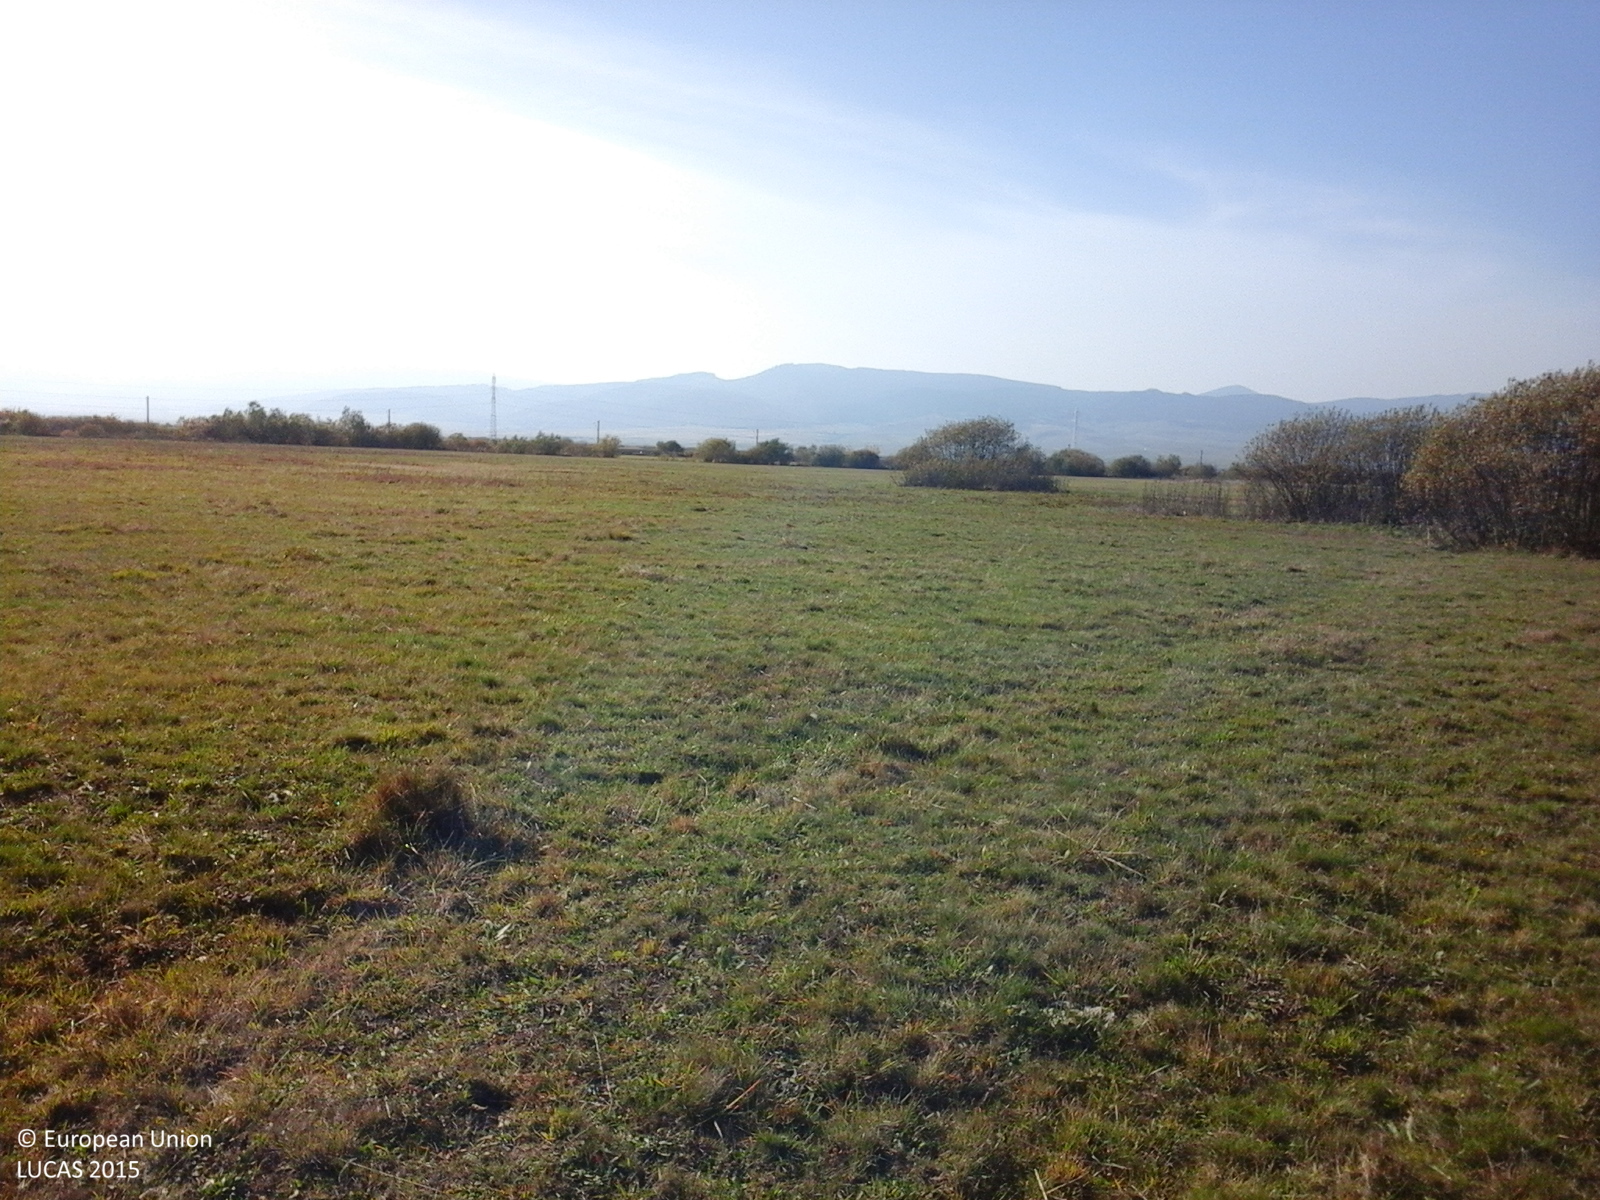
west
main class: Grassland
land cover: Grassland without tree/shrub cover
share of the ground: > 75 %
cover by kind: herbaceous plants 100 %
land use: Agriculture (excluding fallow land and kitchen gardens)
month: October
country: RO
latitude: 46.7707
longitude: 25.4978
